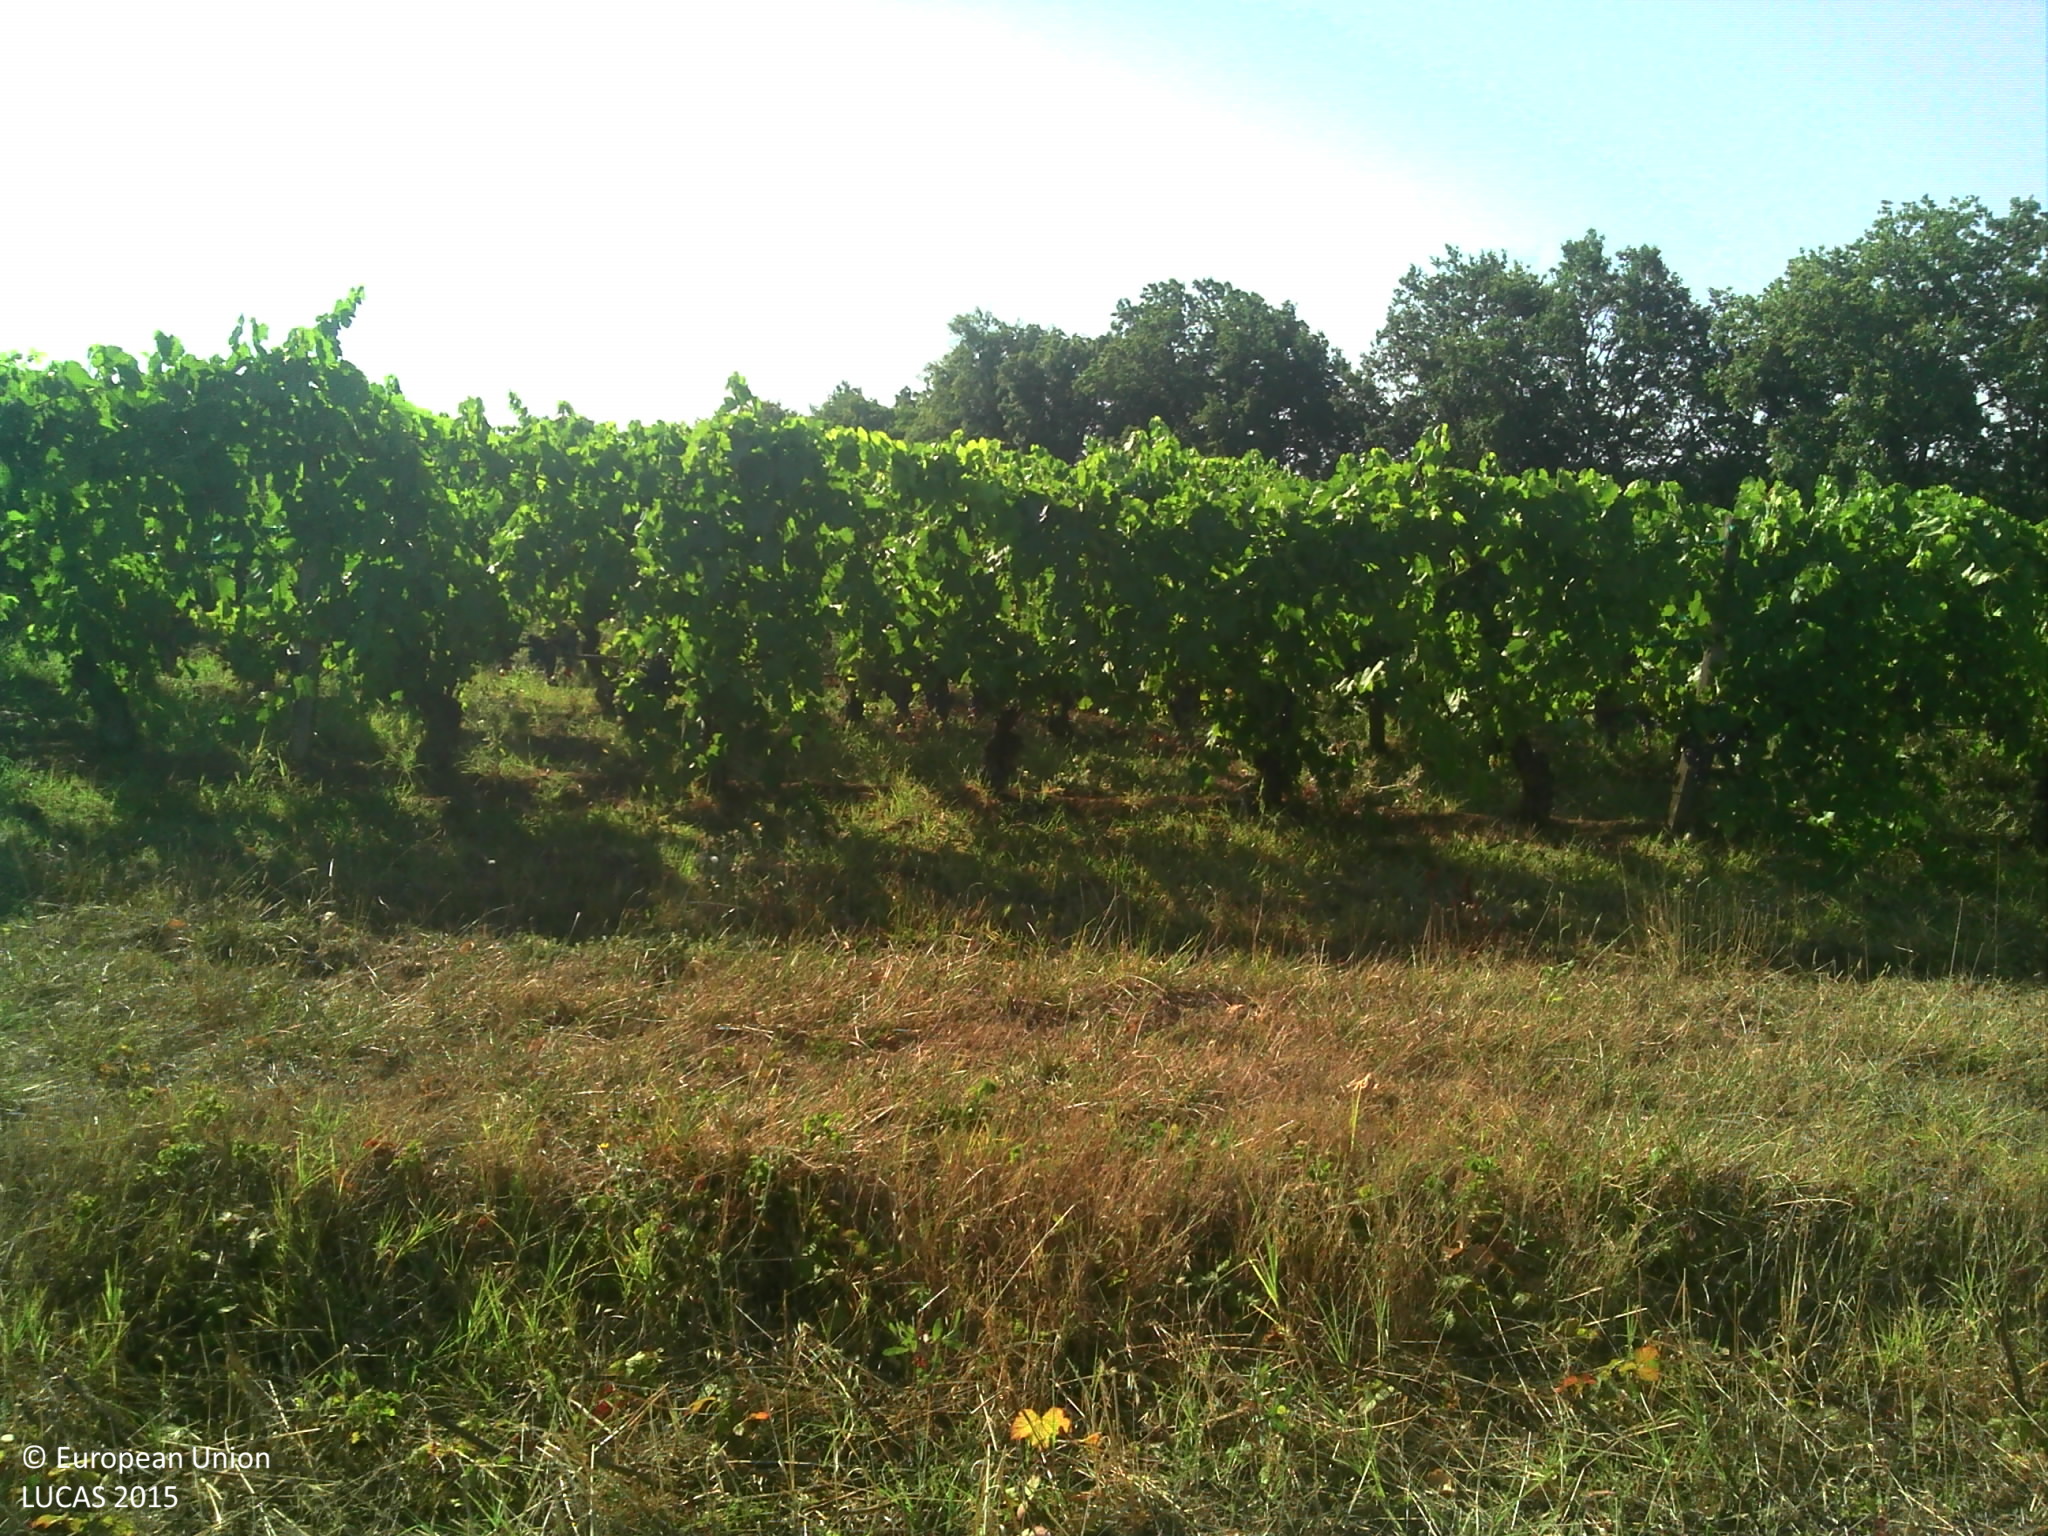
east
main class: Cropland
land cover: Dry pulses
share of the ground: 50 - 75 %
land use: Agriculture (excluding fallow land and kitchen gardens)
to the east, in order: Dry pulses; Tracks; Vineyards; Ditches and canals; Tracks; Other fresh vegetables; Durum wheat
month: August
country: FR
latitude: 44.2318
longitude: 1.2218
